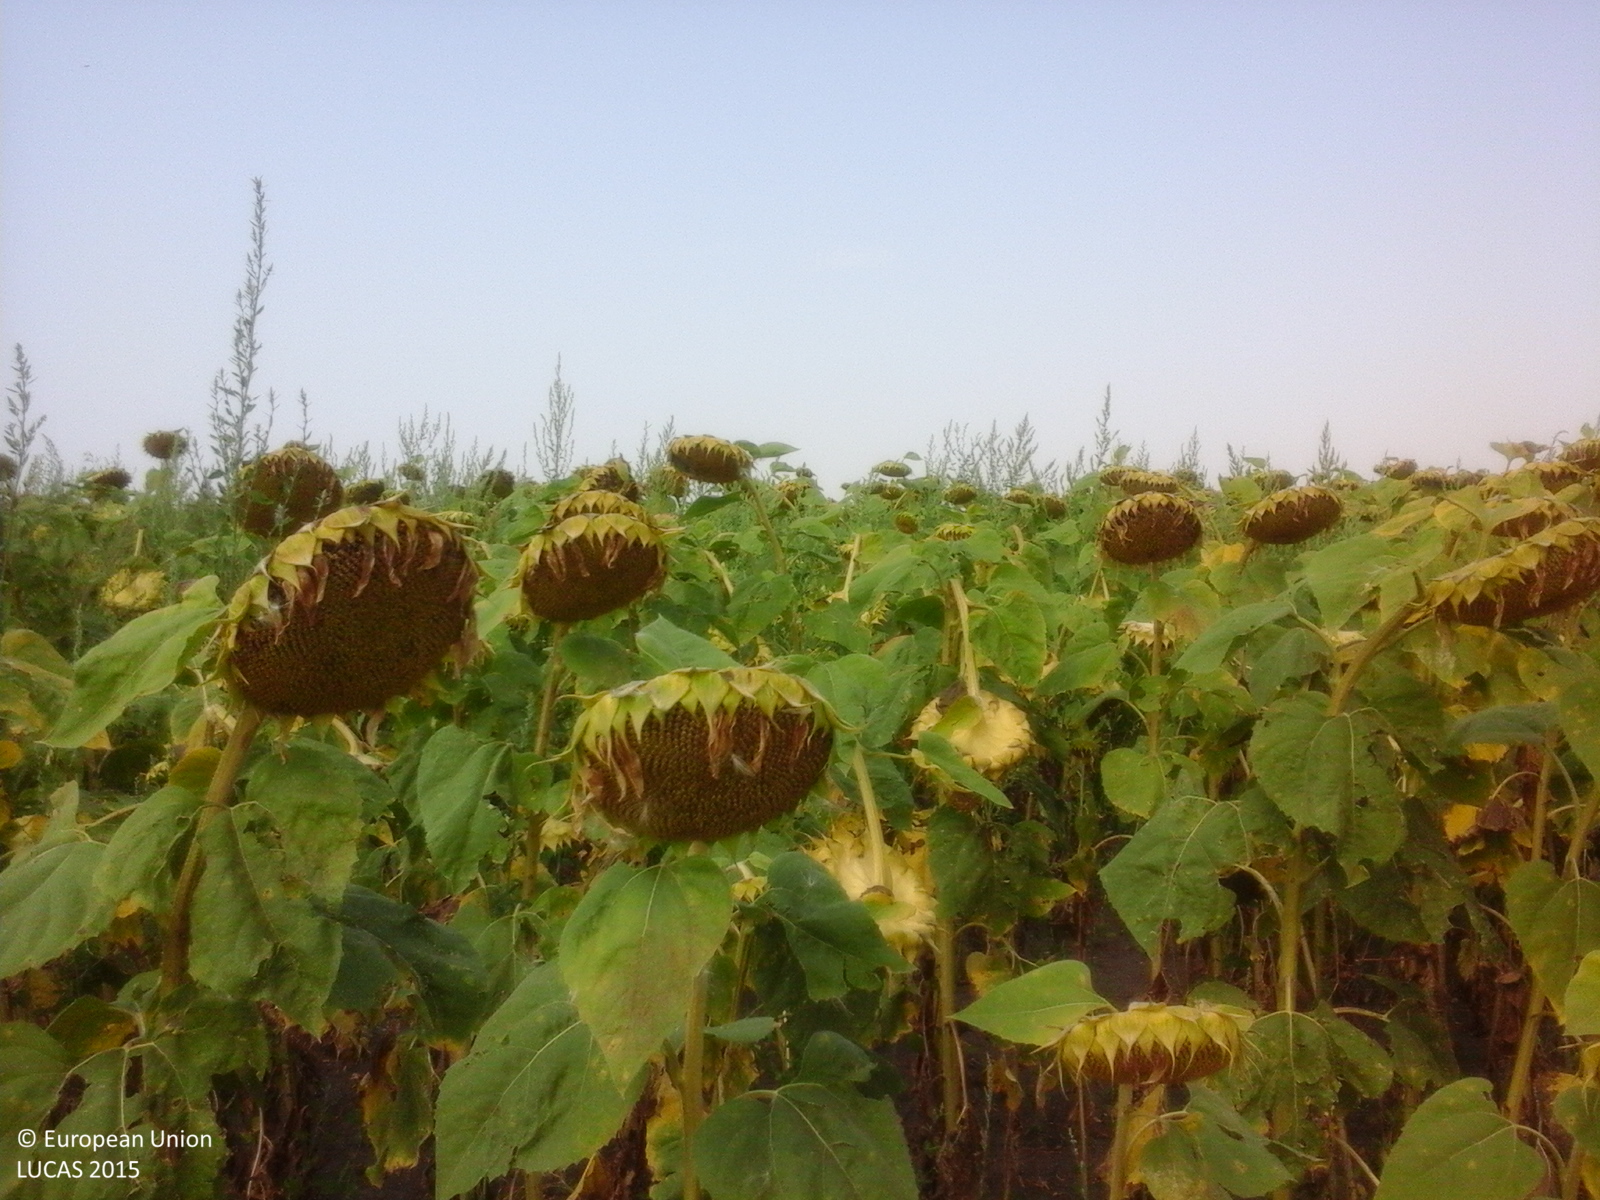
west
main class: Cropland
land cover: Sunflower
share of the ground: > 75 %
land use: Agriculture (excluding fallow land and kitchen gardens)
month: August
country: RO
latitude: 43.8787
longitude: 23.4005
